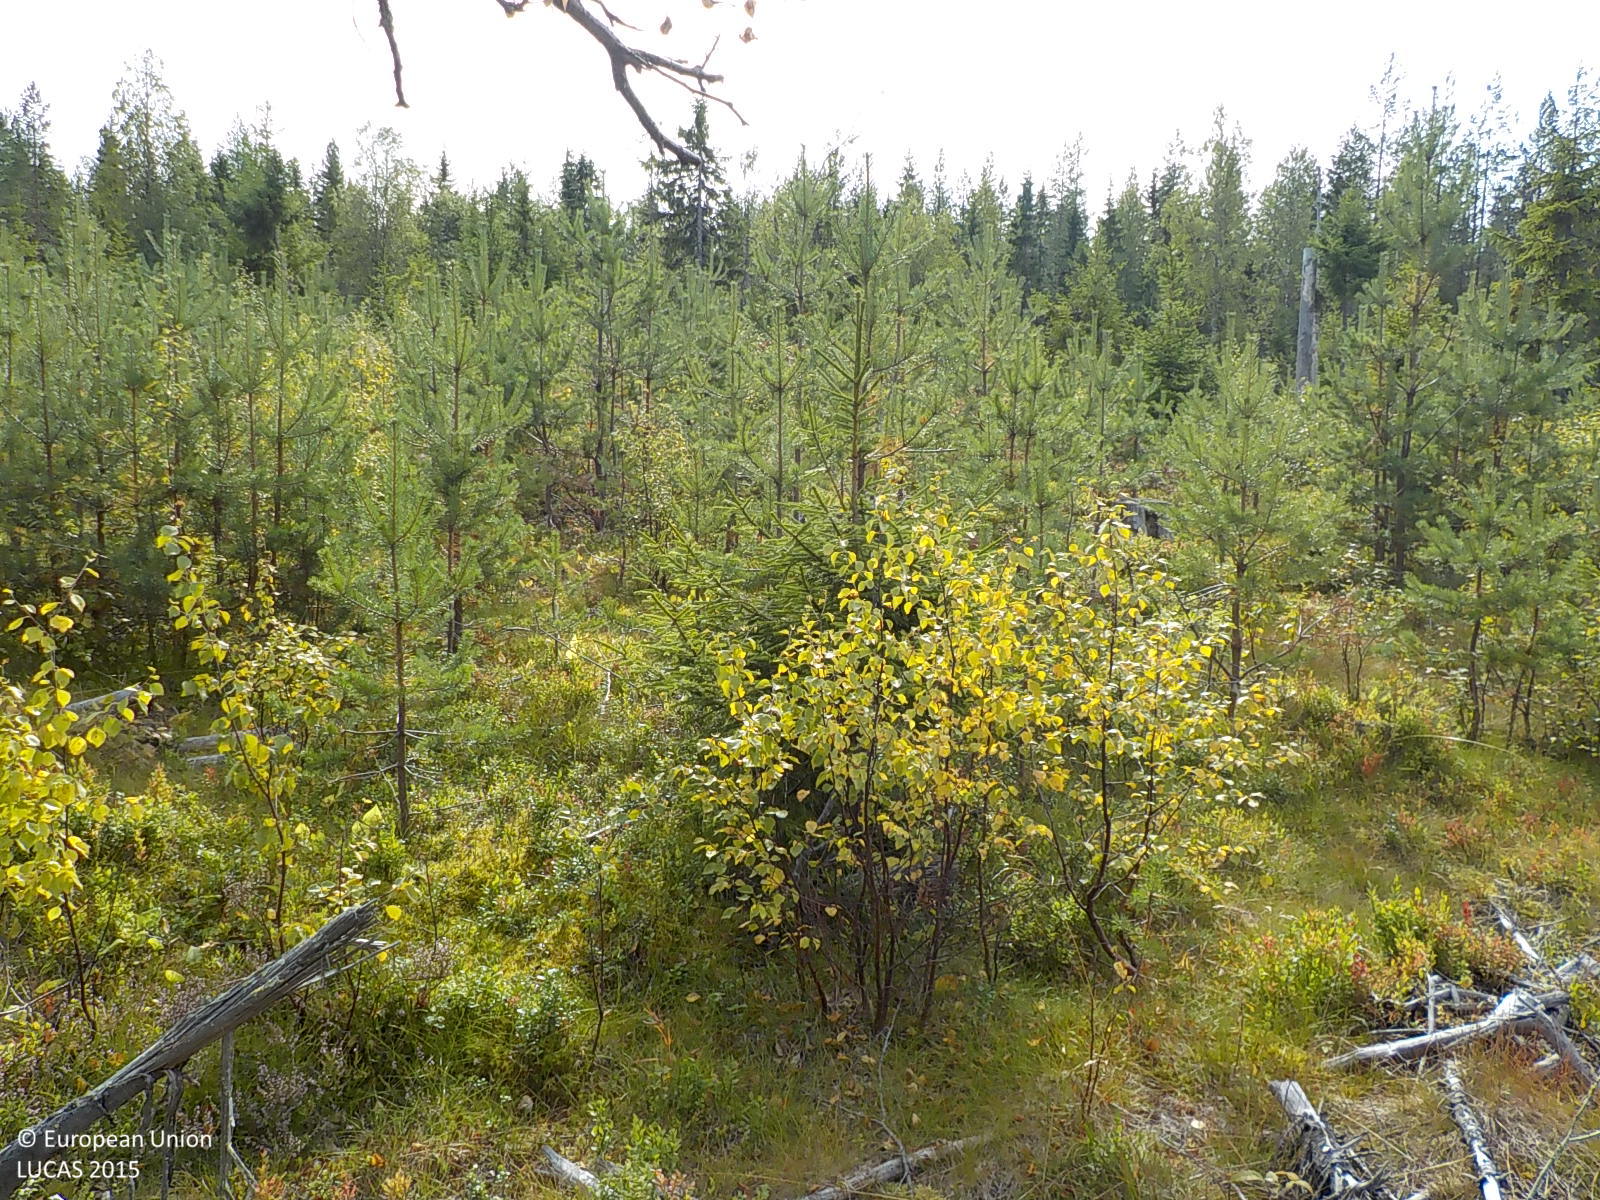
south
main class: Woodland
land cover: Spruce dominated coniferous woodland
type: boreal forest
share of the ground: > 75 %
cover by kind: coniferous forest trees 70 %, shrubs 20 %, broadleaved forest trees 5 %, herbaceous plants 5 %
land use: Forestry
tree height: > 5 m
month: September
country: SE
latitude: 63.3159
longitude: 17.8197
